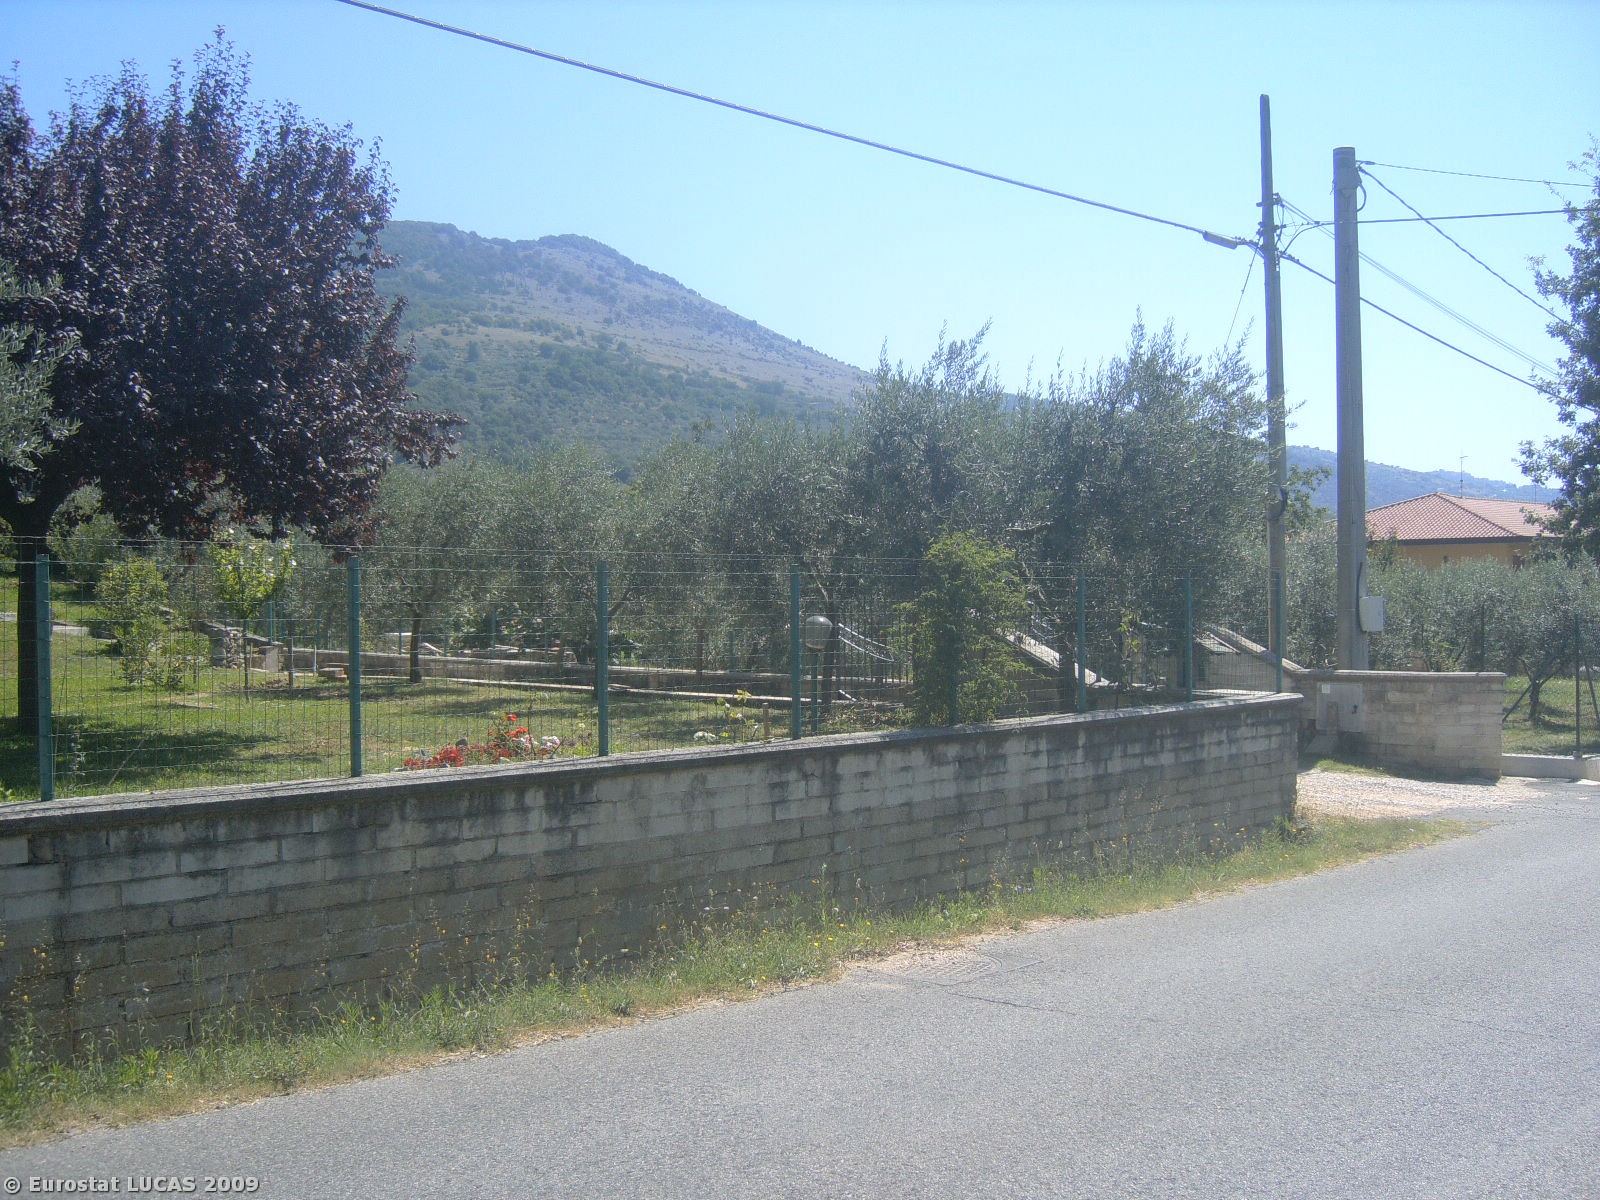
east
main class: Grassland
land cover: Grassland with sparse tree/shrub cover
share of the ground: 25 - 50 %
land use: Residential
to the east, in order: Grassland with sparse tree/shrub cover; Artificial constructions in urban areas; Olive groves; Grassland with sparse tree/shrub cover; Tracks; Olive groves; Grassland with sparse tree/shrub cover
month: July
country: IT
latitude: 41.7121
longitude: 13.3648
